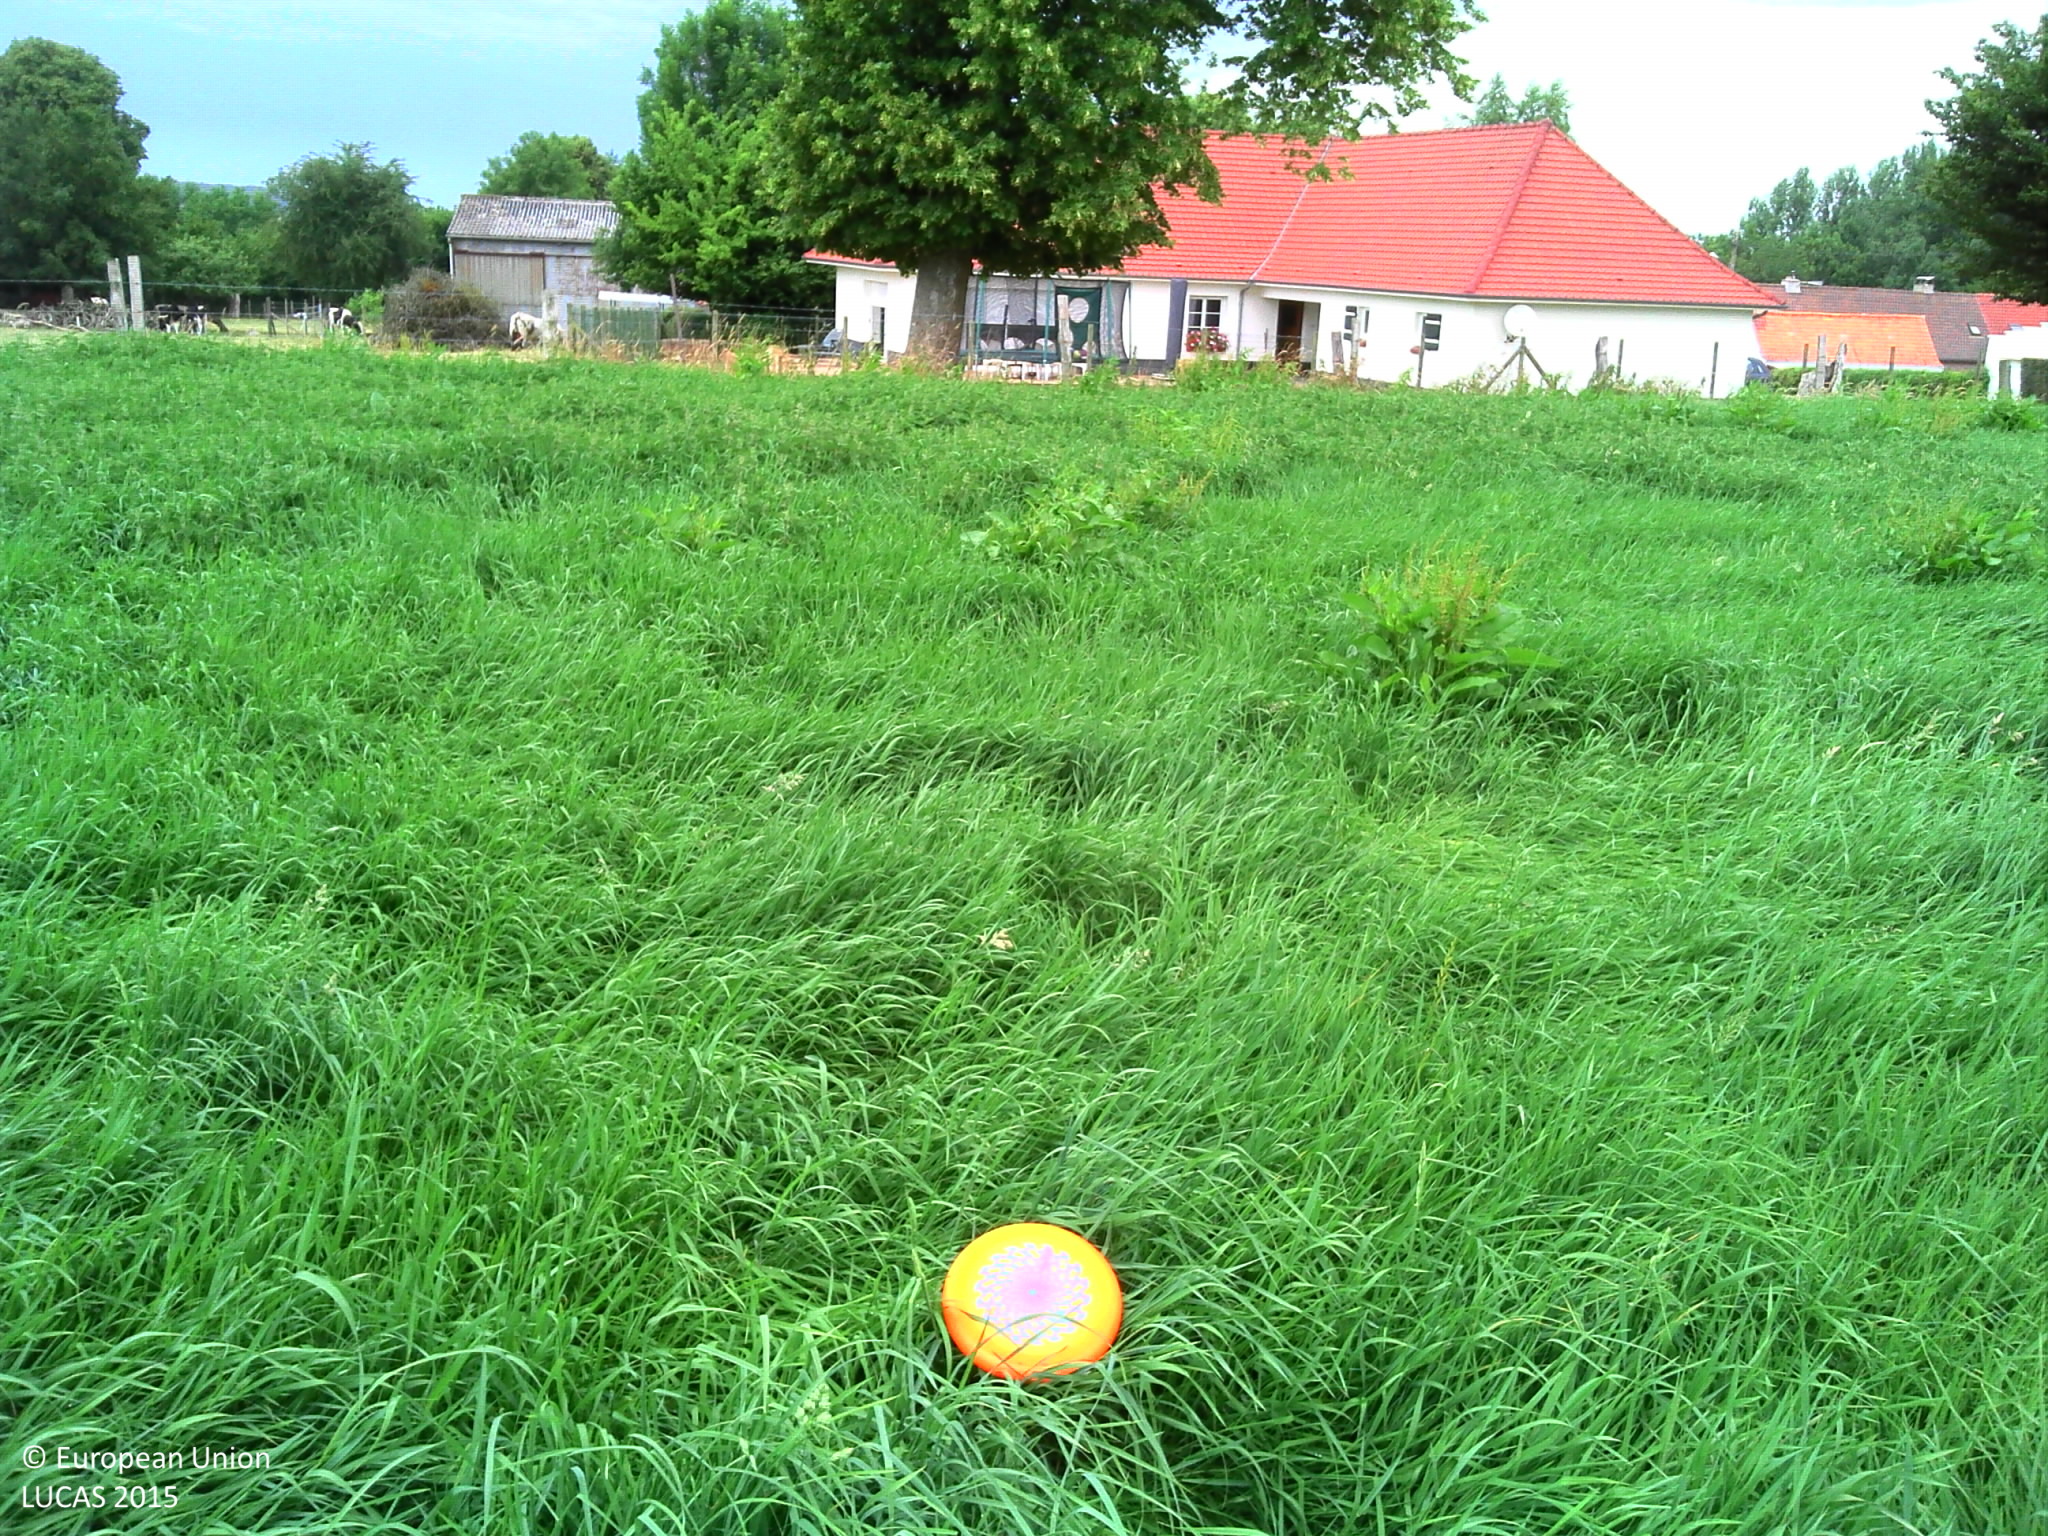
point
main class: Grassland
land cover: Grassland without tree/shrub cover
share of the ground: > 75 %
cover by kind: herbaceous plants 100 %
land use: Agriculture (excluding fallow land and kitchen gardens)
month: July
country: FR
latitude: 50.3794
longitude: 2.0959
